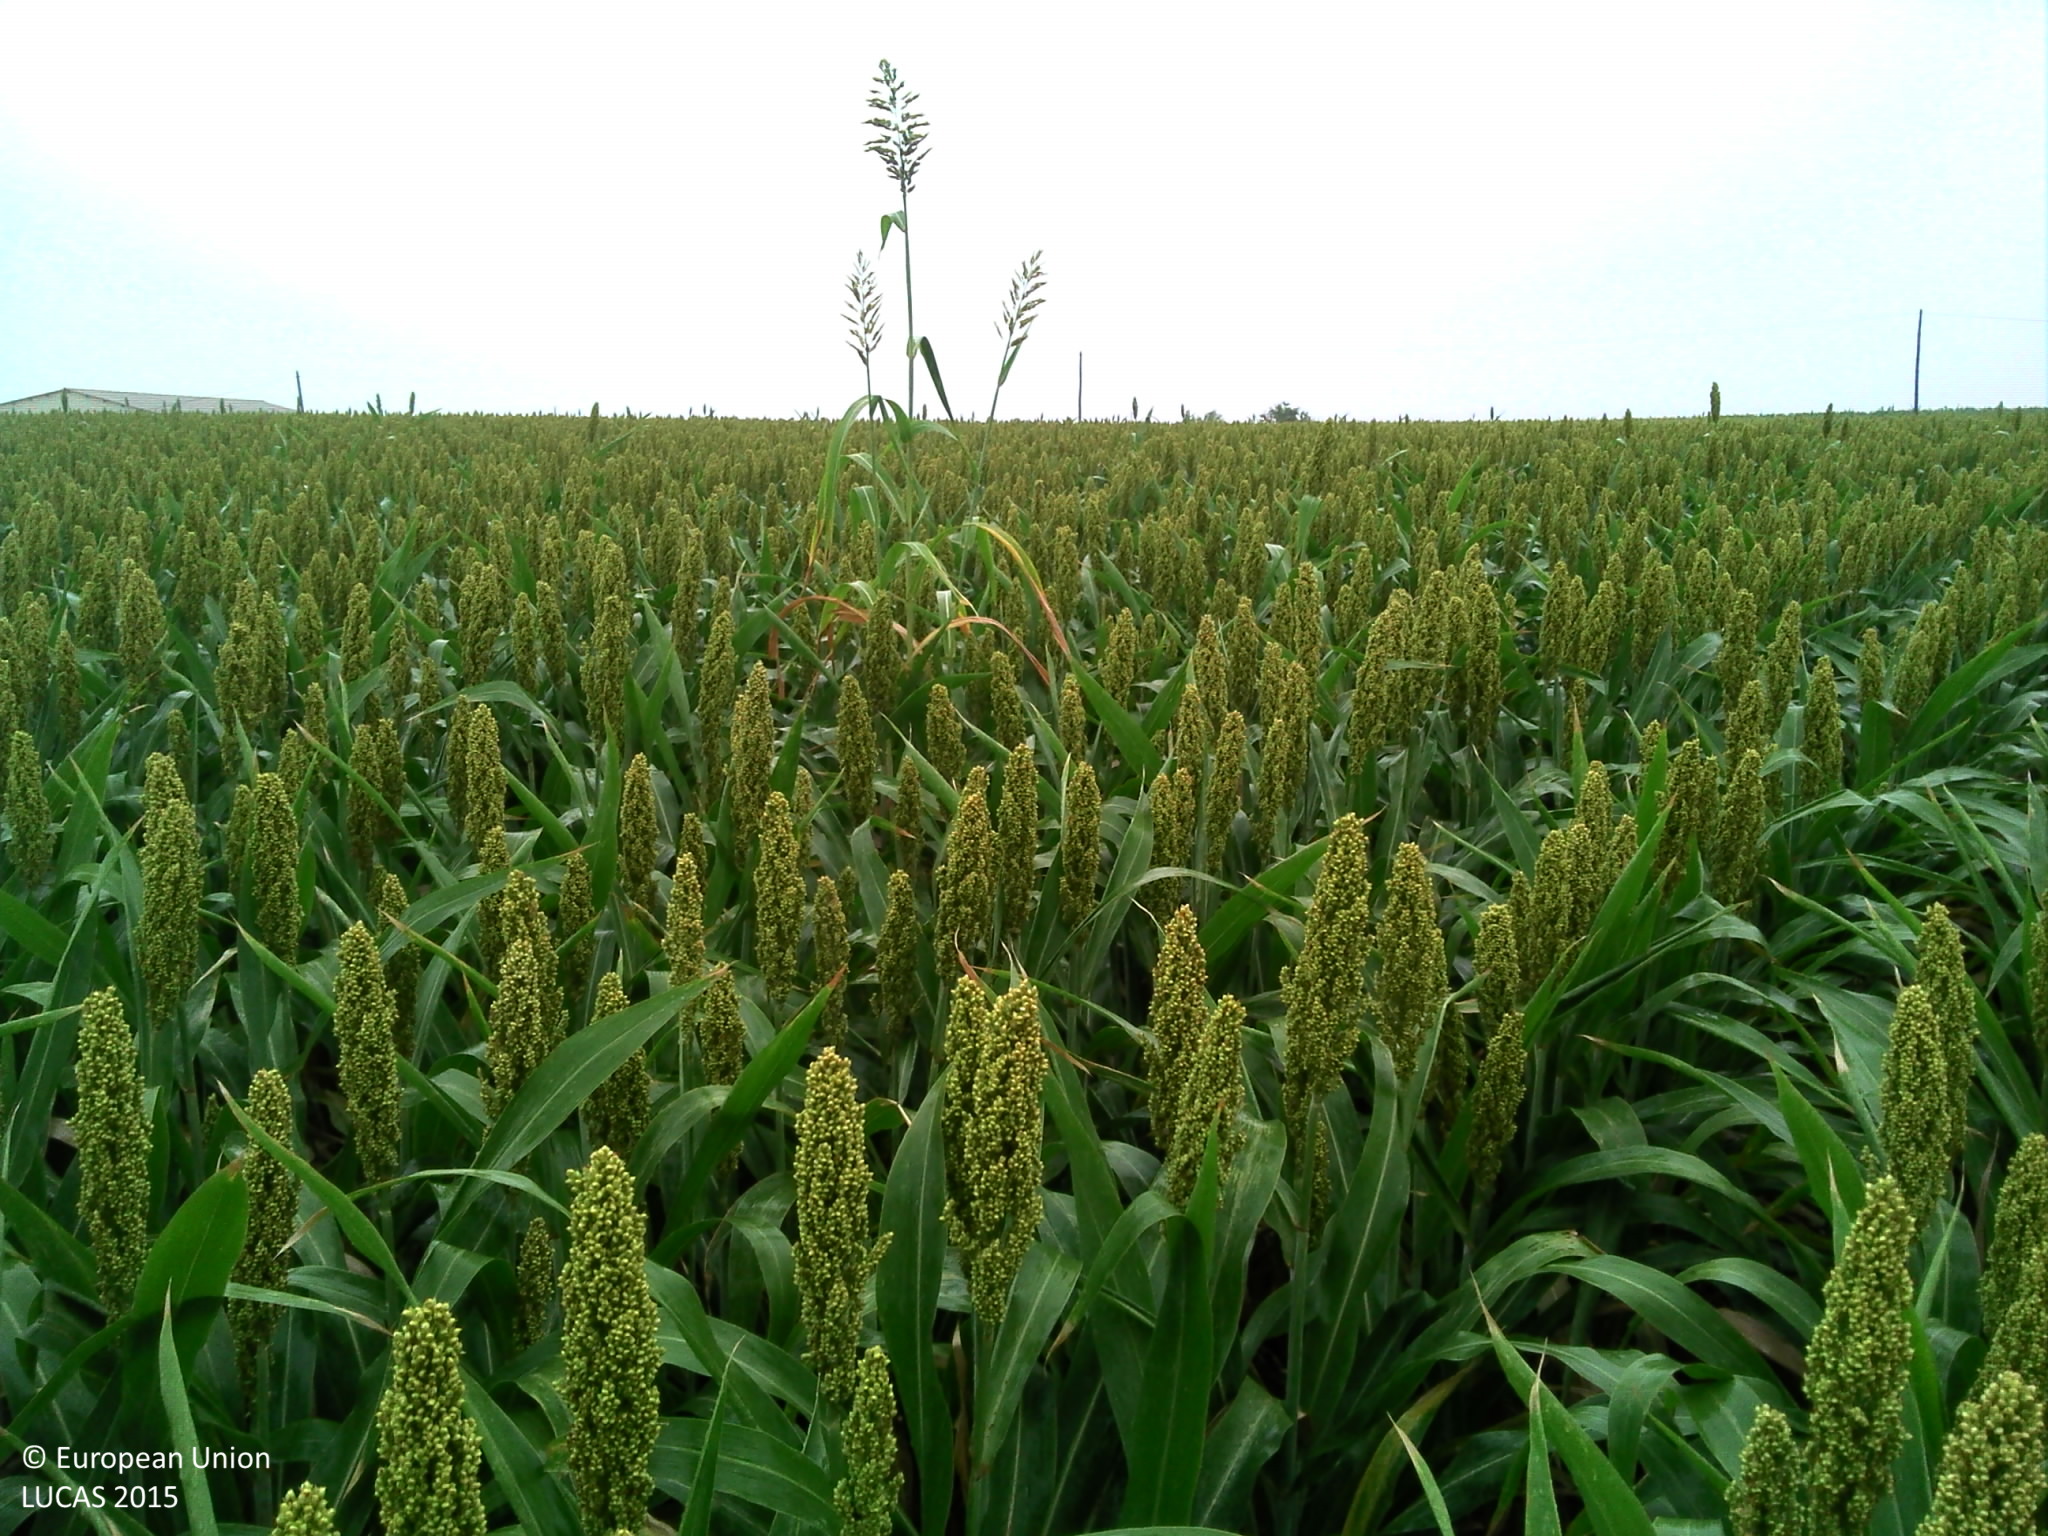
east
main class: Cropland
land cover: Other cereals
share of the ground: > 75 %
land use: Agriculture (excluding fallow land and kitchen gardens)
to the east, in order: Other cereals; Electric lines; Grass margins; Paved roads, cycling and walking lanes; Grass margins; Maize
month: July
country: FR
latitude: 44.1816
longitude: 0.8521
